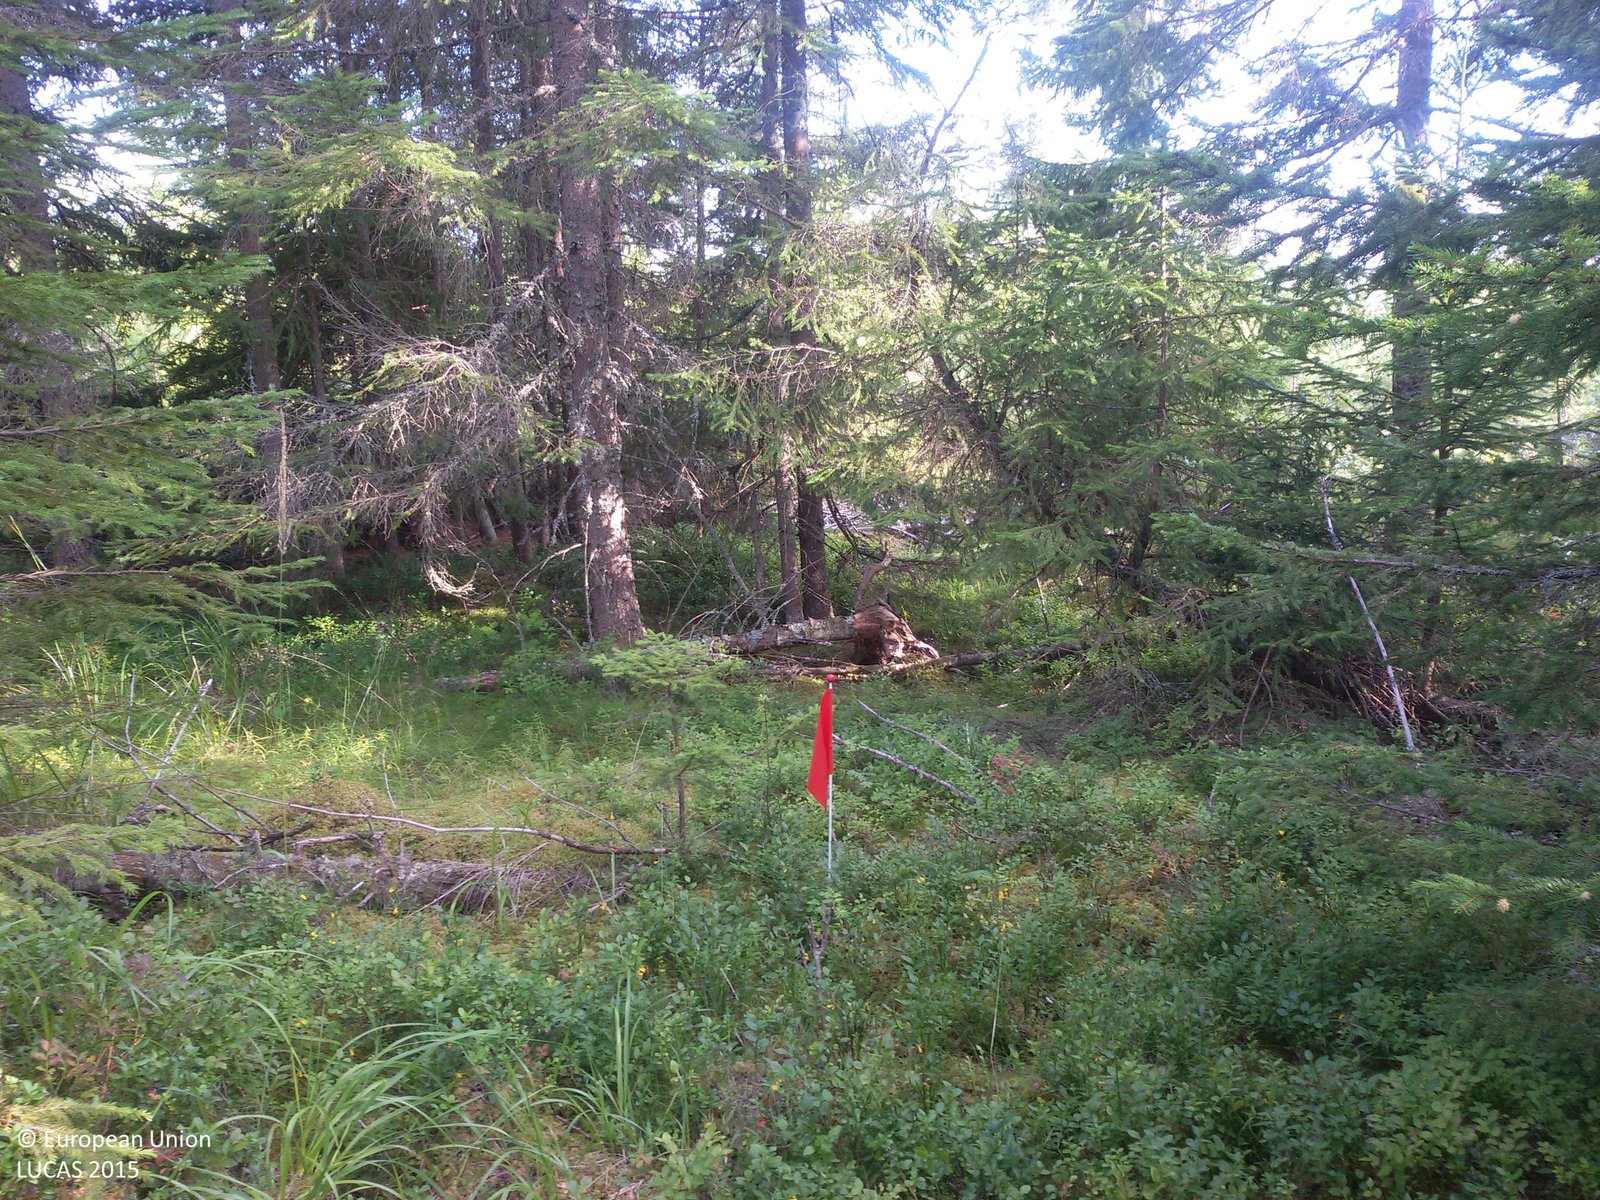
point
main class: Woodland
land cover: Spruce dominated coniferous woodland
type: boreal forest
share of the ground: 50 - 75 %
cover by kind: coniferous forest trees 70 %, lichens and mosses 15 %, shrubs 10 %, herbaceous plants 5 %
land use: Forestry
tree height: > 5 m
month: August
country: SE
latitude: 60.4067
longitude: 16.5787
